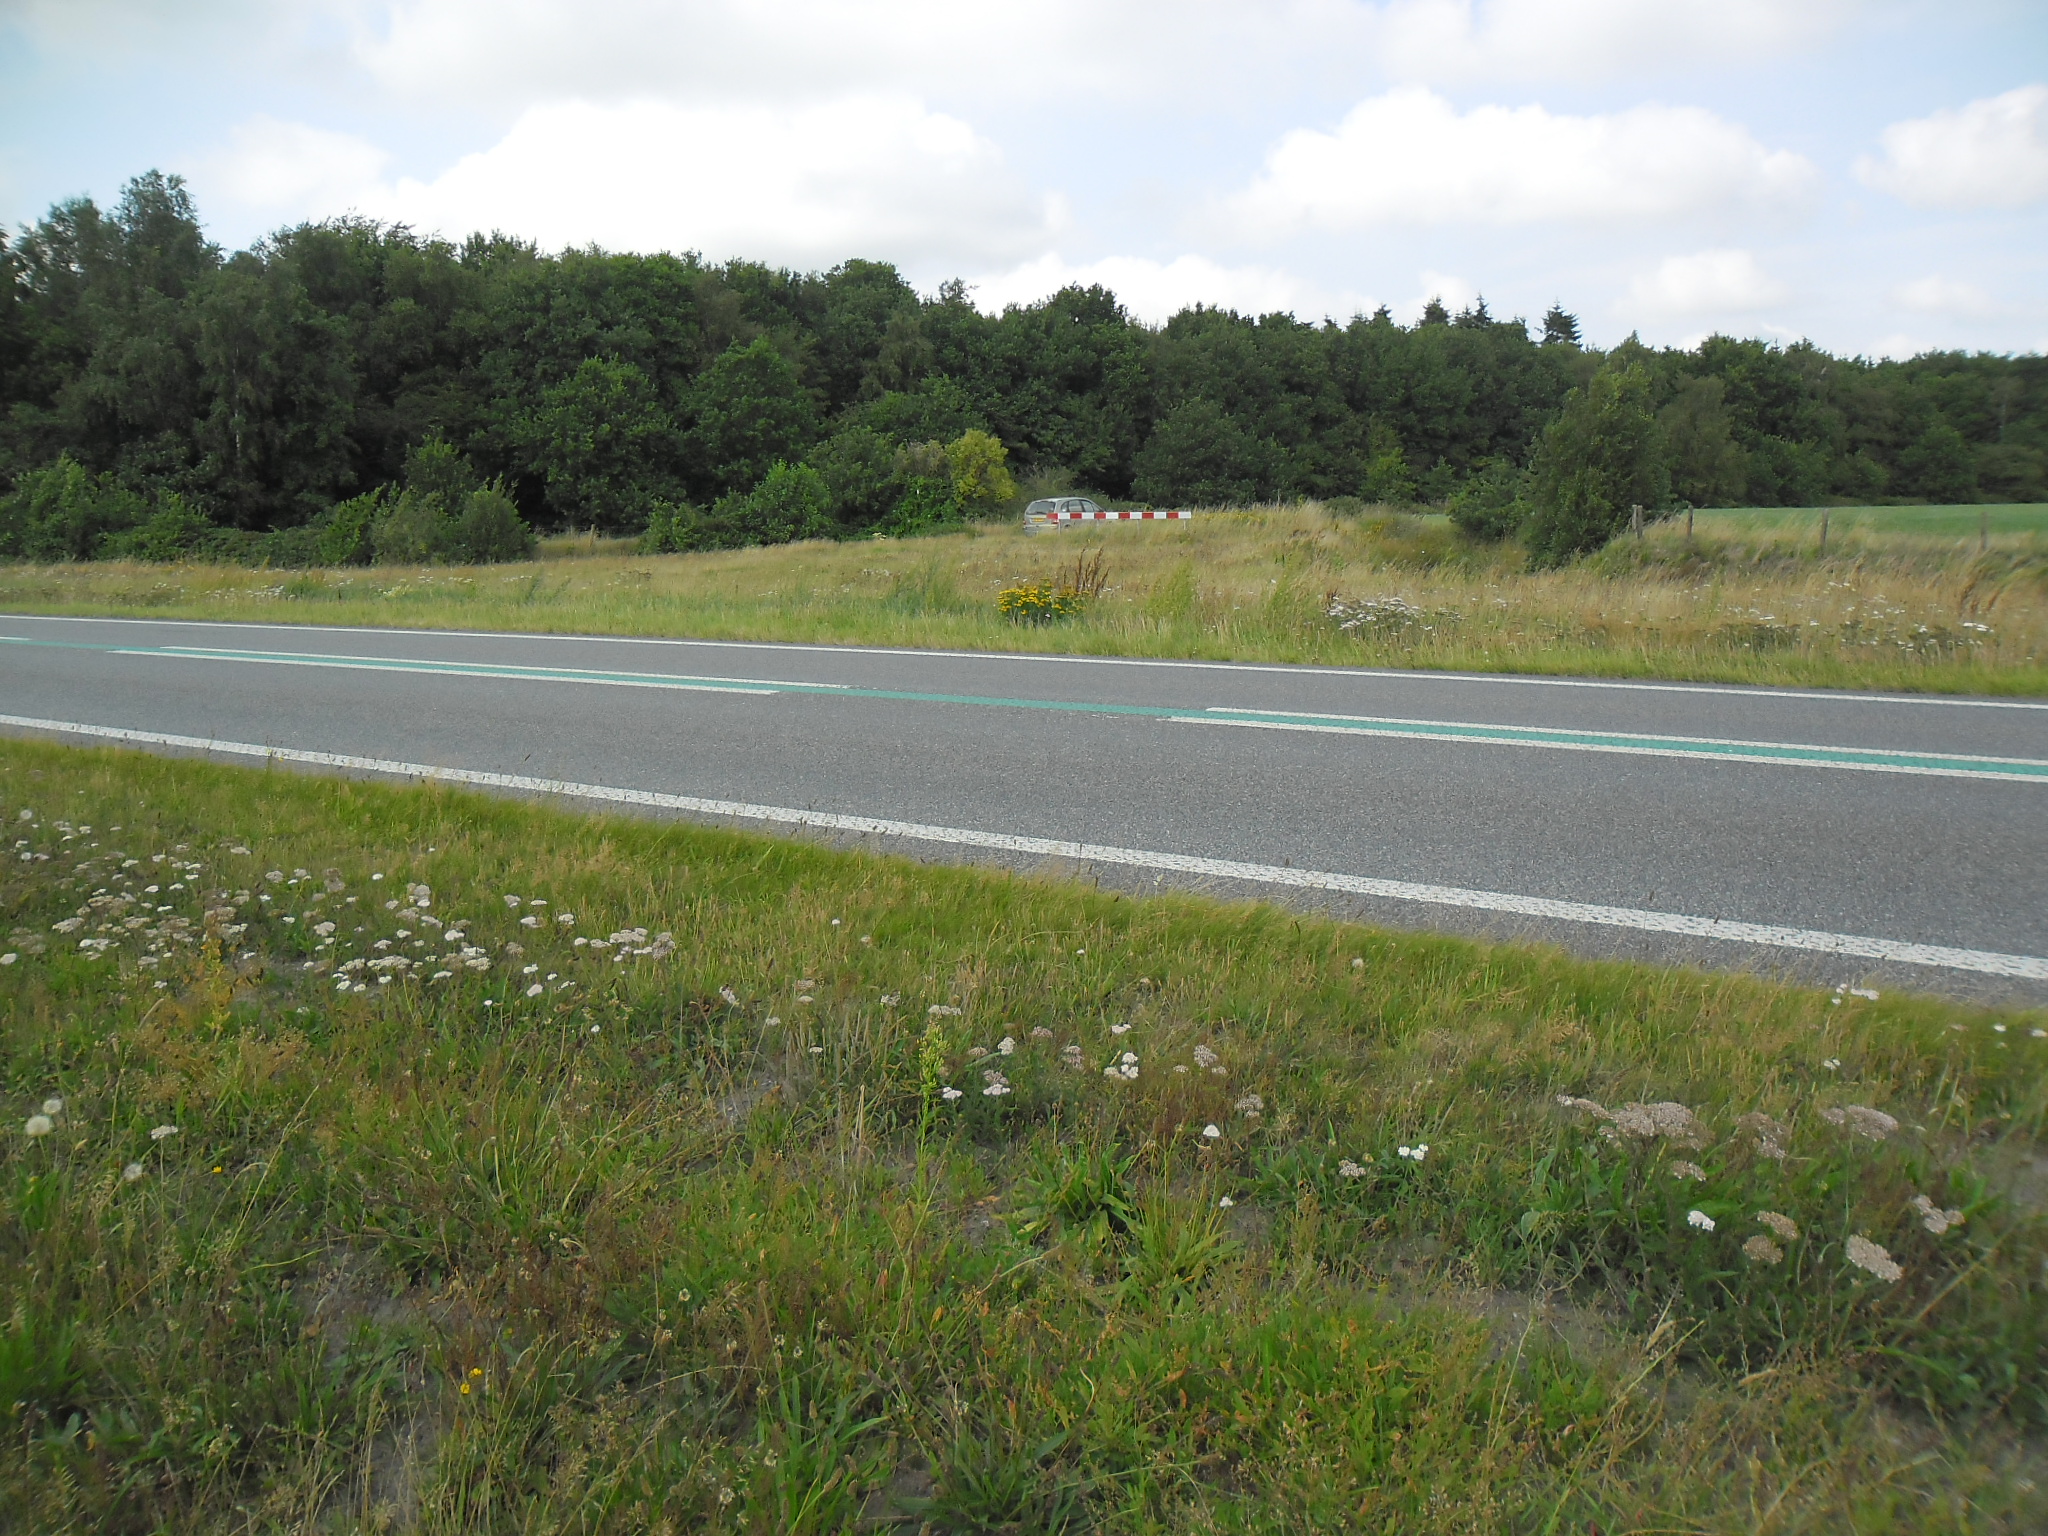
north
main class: Cropland
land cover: Maize
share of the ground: > 75 %
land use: Agriculture (excluding fallow land and kitchen gardens)
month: August
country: NL
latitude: 52.8895
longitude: 5.5845
